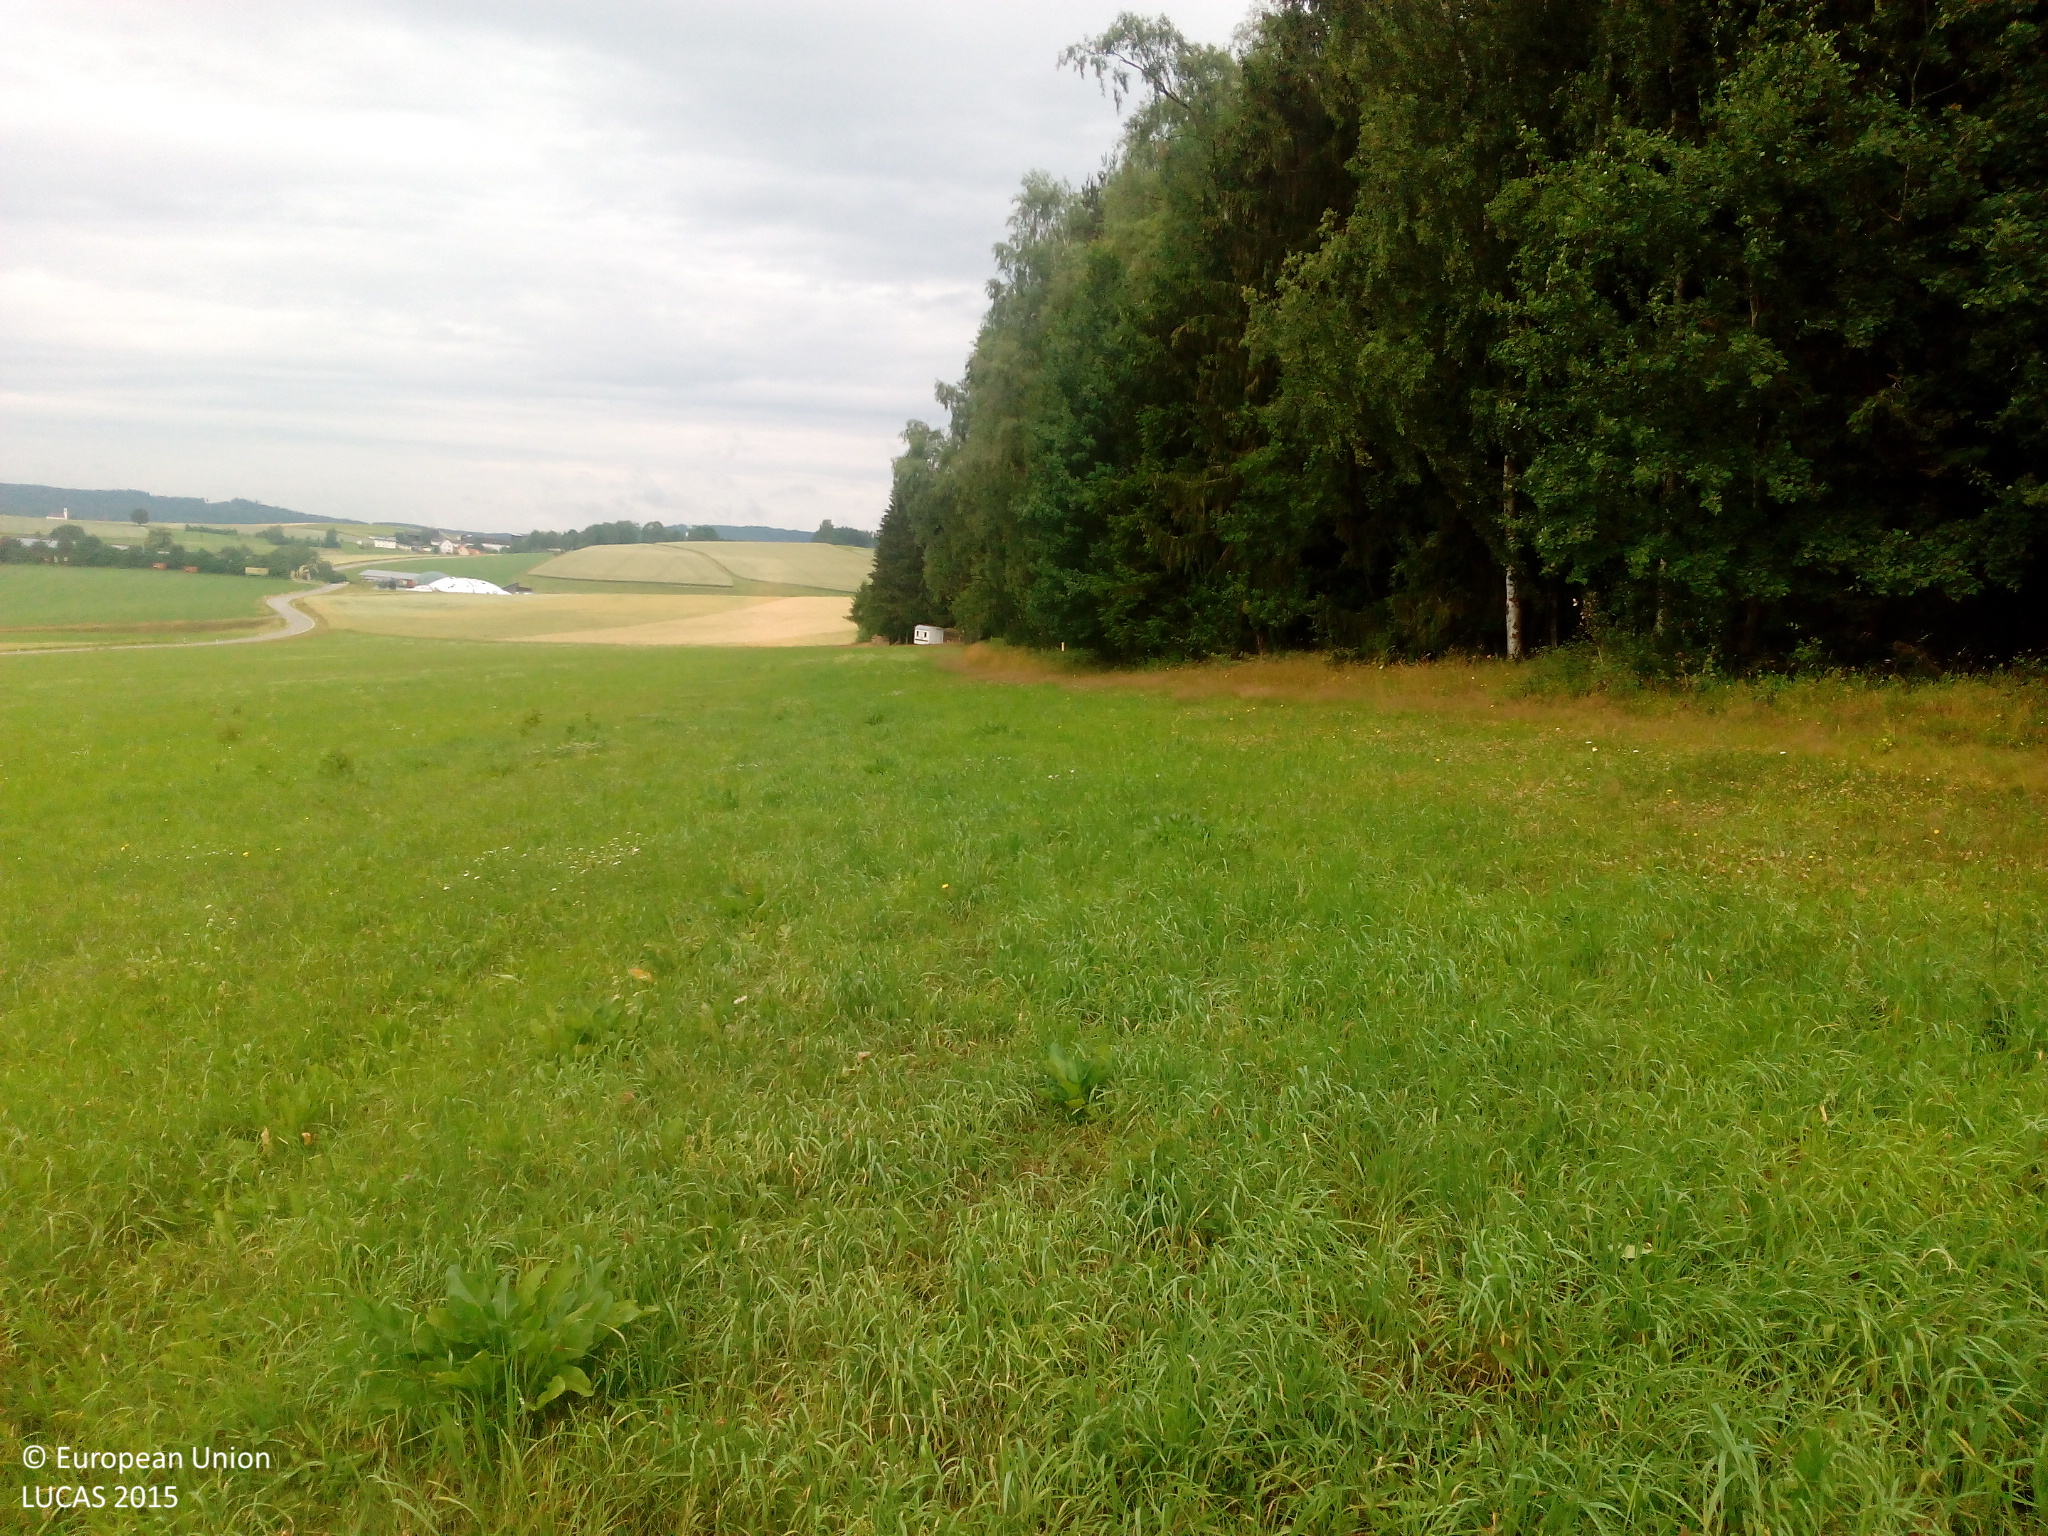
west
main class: Grassland
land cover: Grassland without tree/shrub cover
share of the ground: > 75 %
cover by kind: herbaceous plants 90 %, unconsolidated bare surface 10 %
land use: Agriculture (excluding fallow land and kitchen gardens)
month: July
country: DE
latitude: 49.6541
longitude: 12.4513
